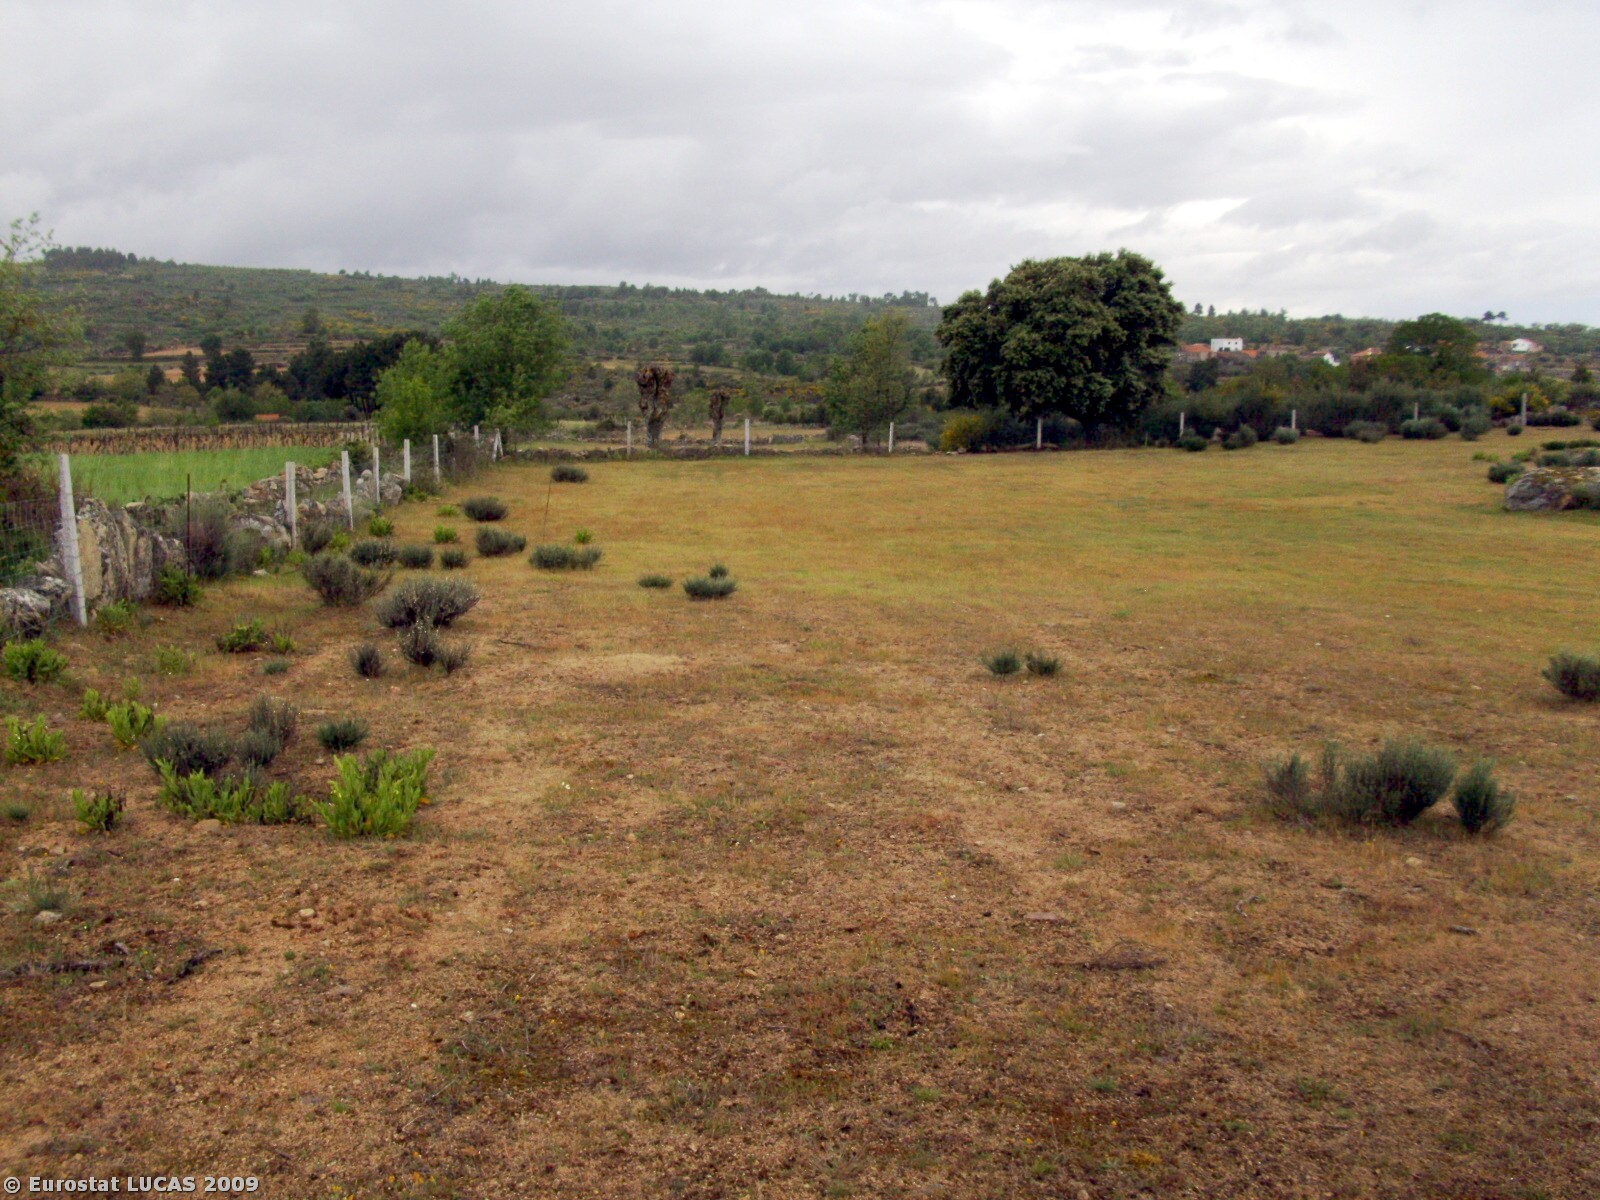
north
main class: Grassland
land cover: Spontaneously vegetated surfaces
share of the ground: > 75 %
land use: Fallow land
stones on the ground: 25 - 50 %
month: May
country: PT
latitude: 40.6881
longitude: -7.1083
